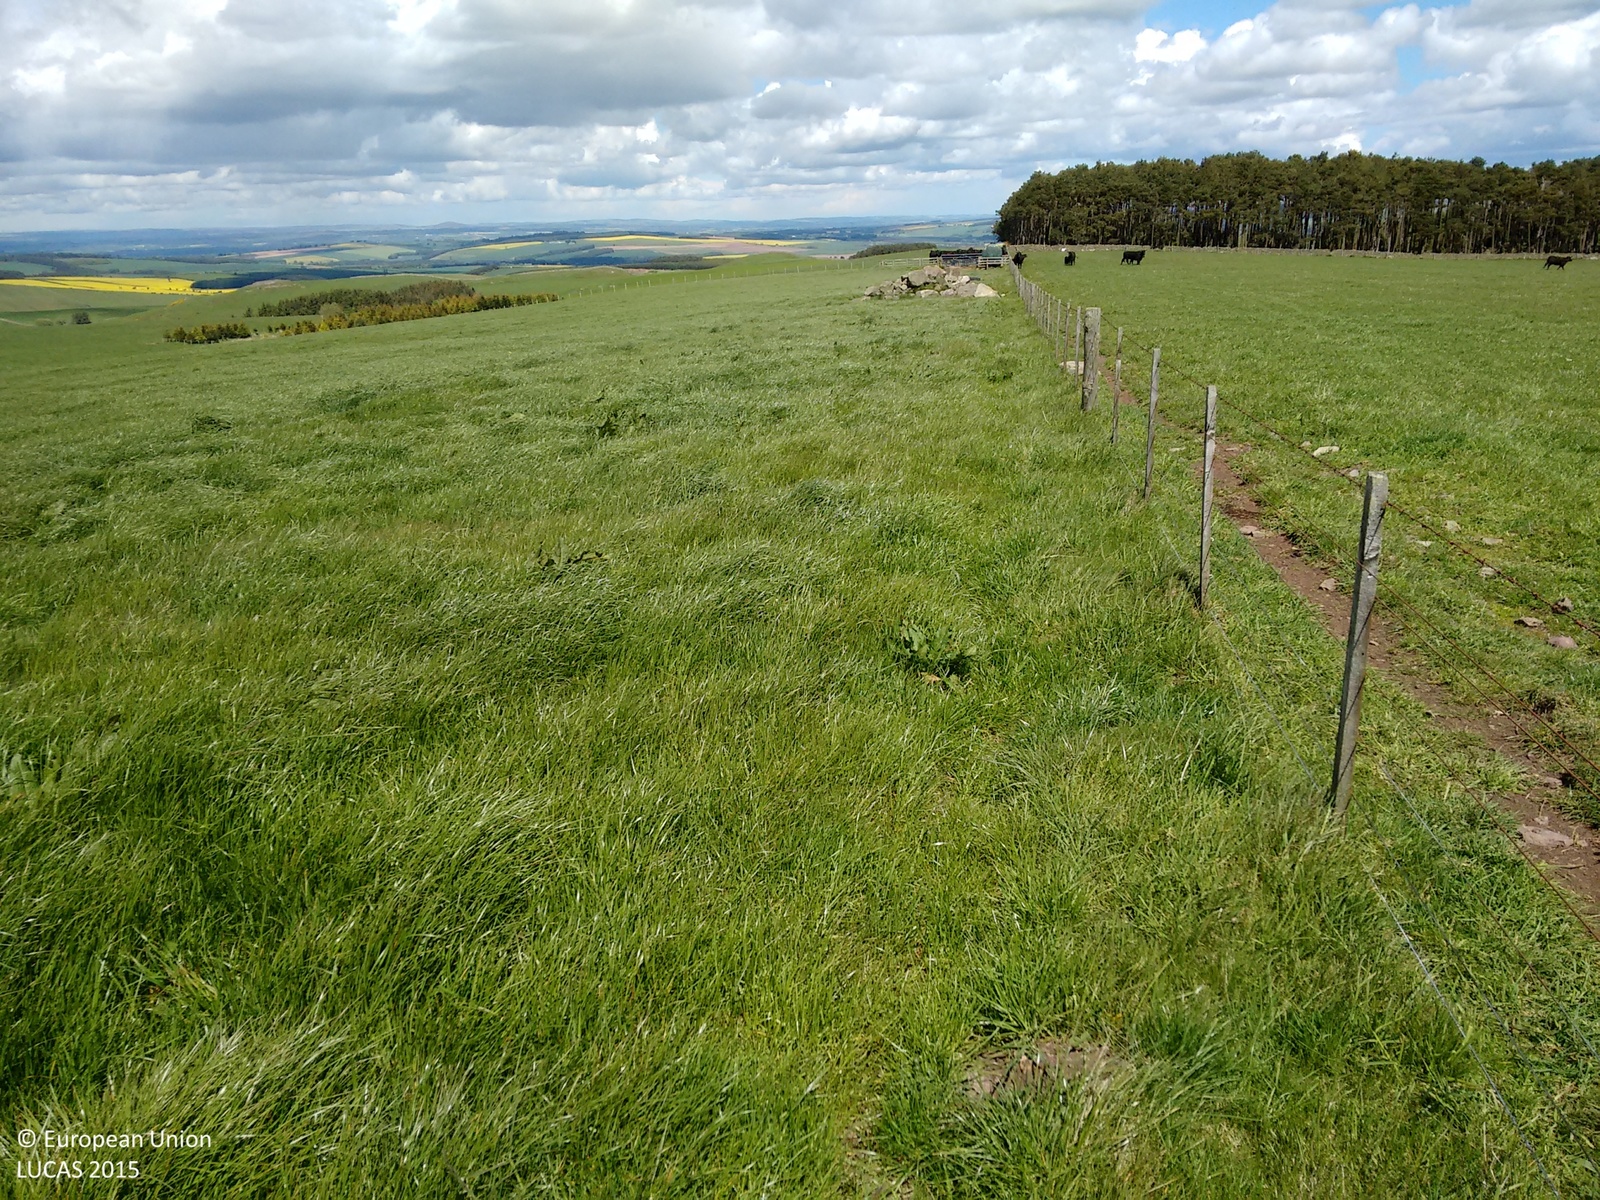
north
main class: Grassland
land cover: Grassland without tree/shrub cover
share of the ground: > 75 %
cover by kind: herbaceous plants 100 %
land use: Agriculture (excluding fallow land and kitchen gardens)
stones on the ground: < 10 %
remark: Harvested field
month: May
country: GB
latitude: 55.4727
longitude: -2.4149
